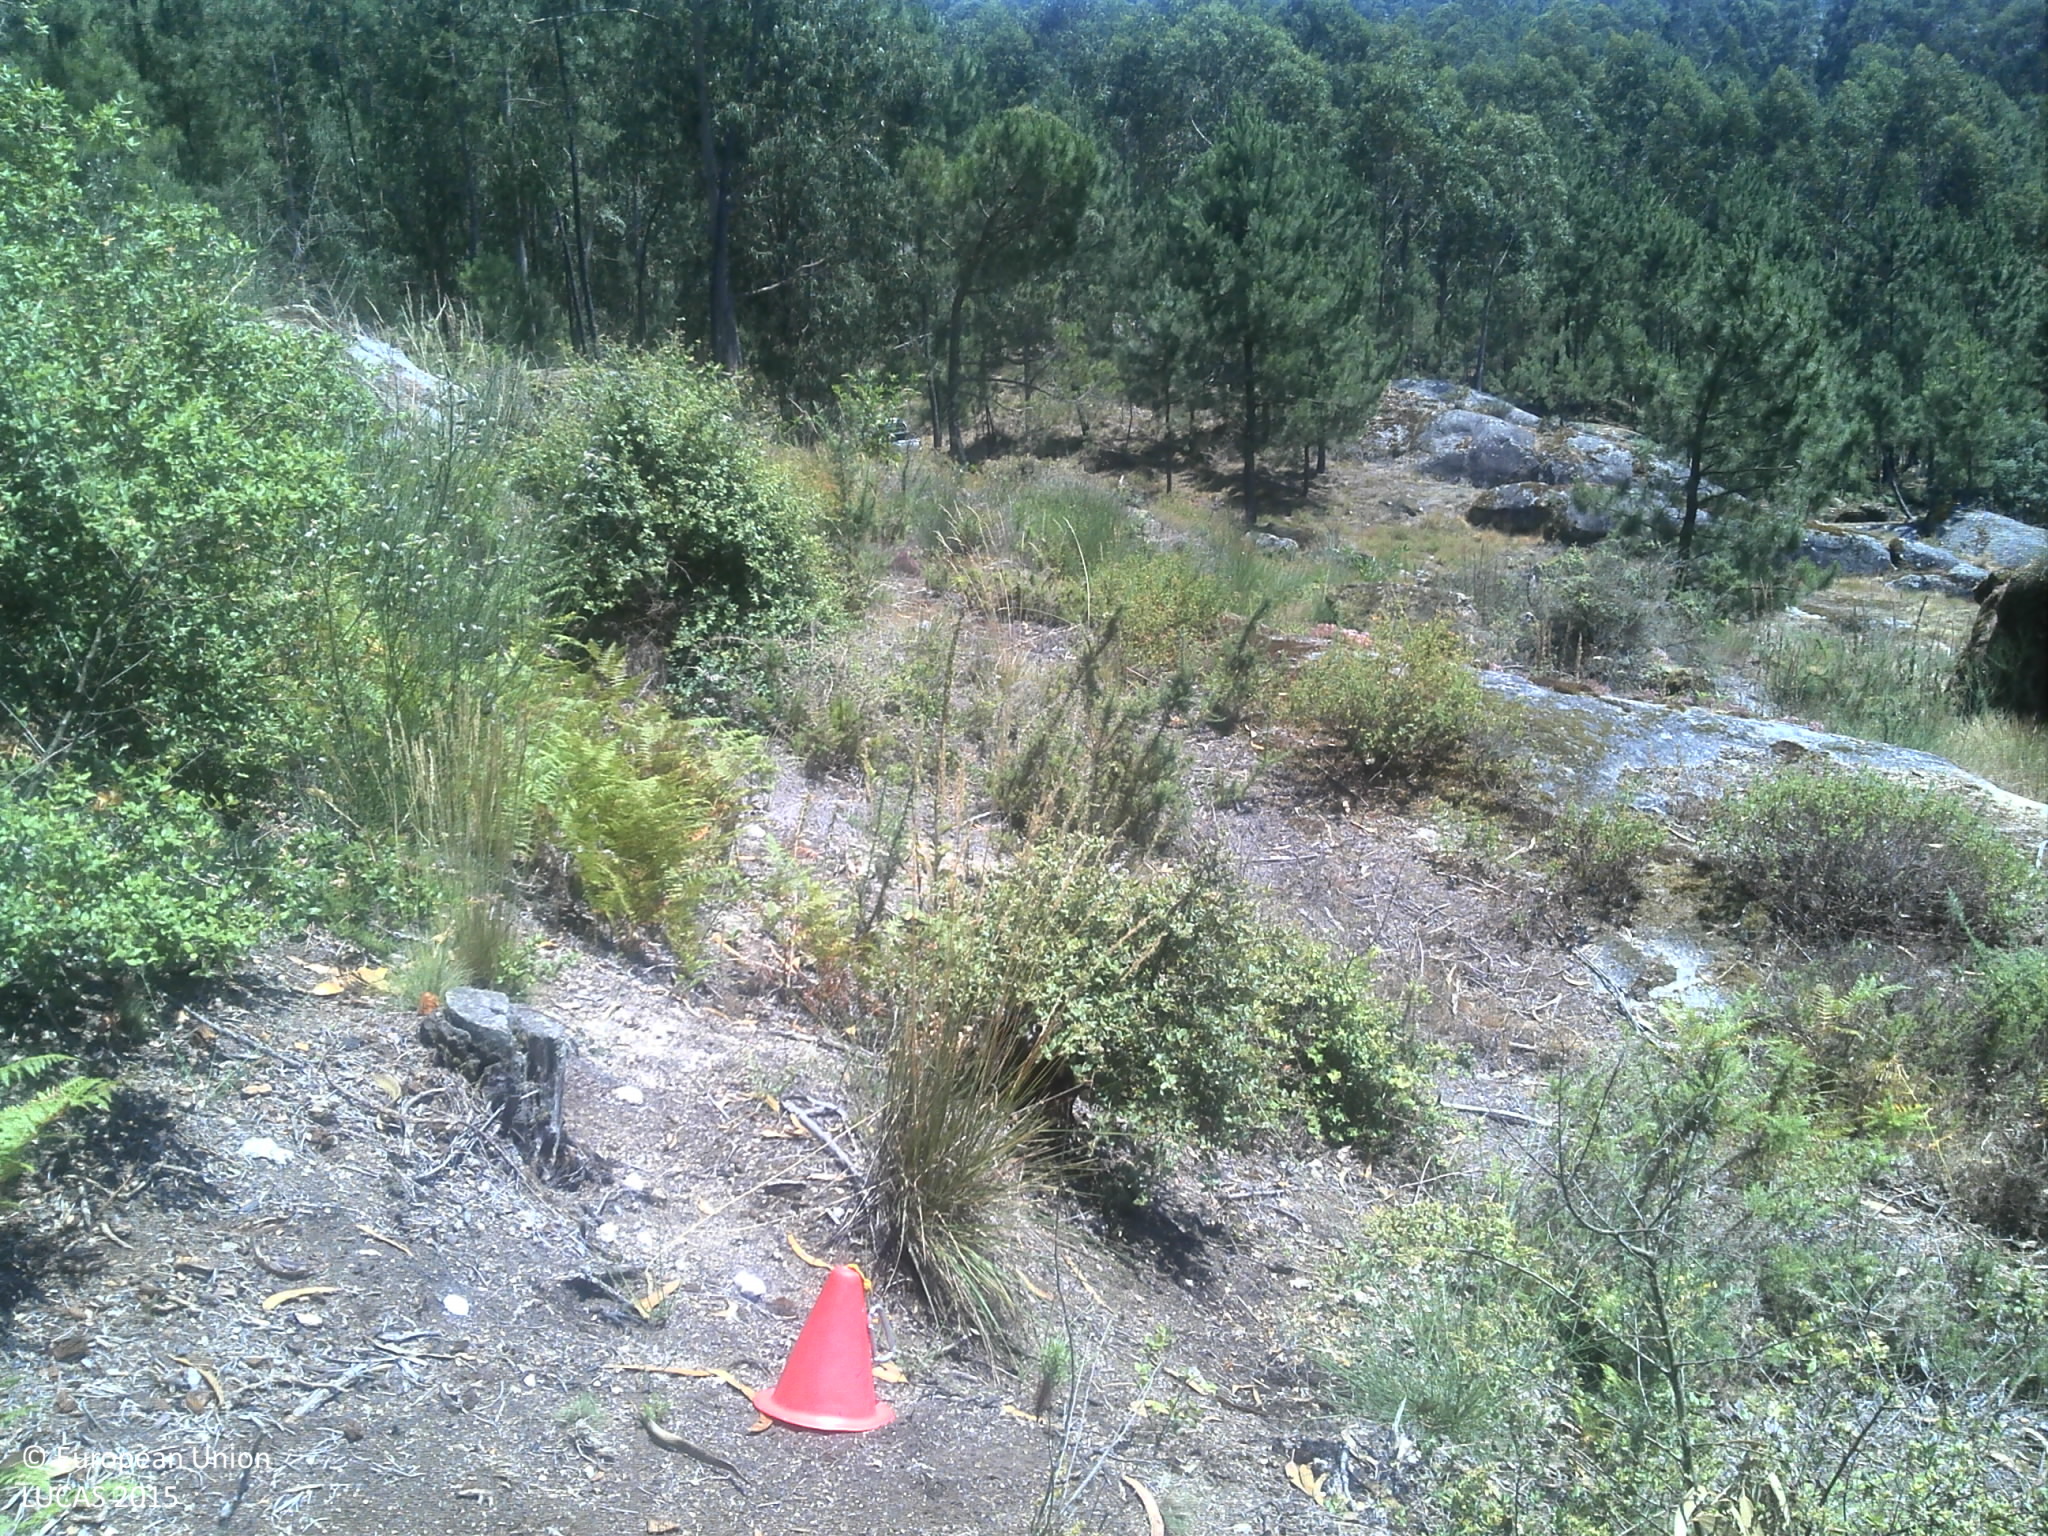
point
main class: Shrubland
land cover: Shrubland with sparse tree cover
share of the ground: 50 - 75 %
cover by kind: shrubs 60 %, unconsolidated bare surface 25 %, consolidated bare surface 10 %, broadleaved forest trees 5 %
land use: Forestry
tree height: < 5 m
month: June
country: PT
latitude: 41.5840
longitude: -8.5711
